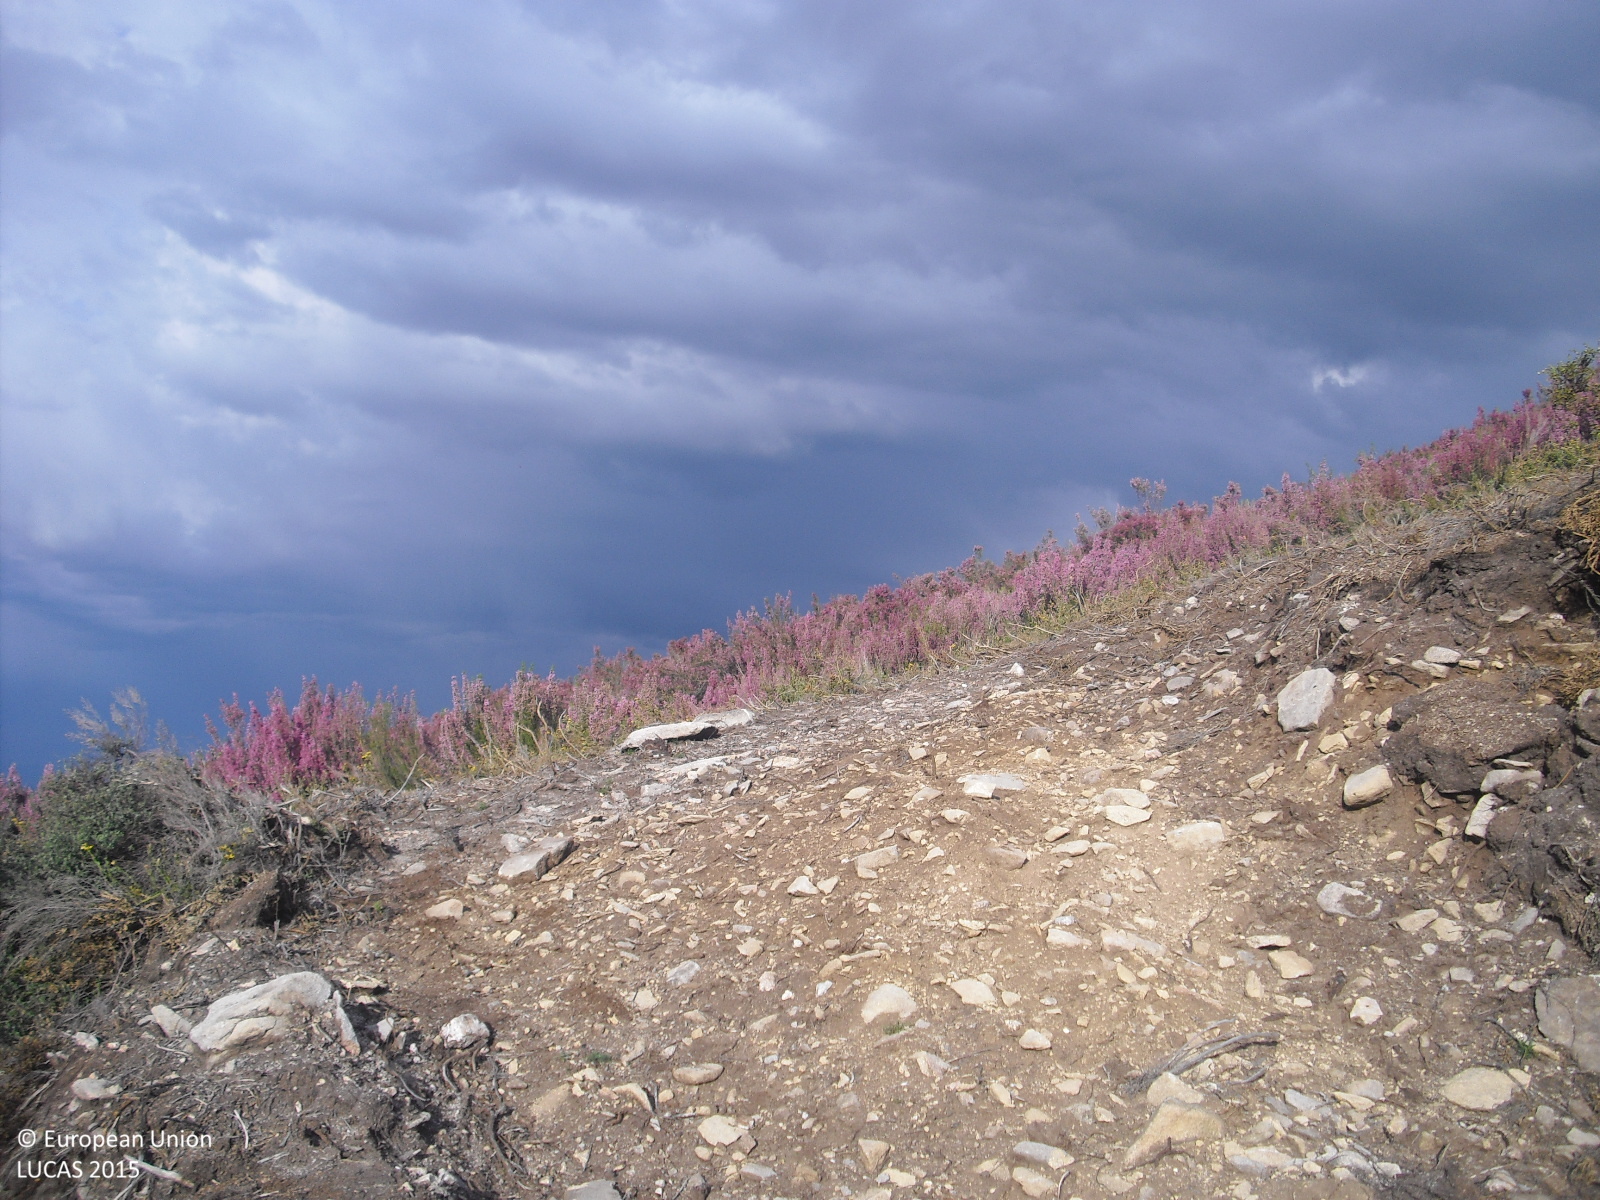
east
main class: Shrubland
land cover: Shrubland without tree cover
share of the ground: > 75 %
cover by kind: shrubs 90 %, herbaceous plants 5 %, unconsolidated bare surface 5 %
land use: Semi-natural and natural areas not in use
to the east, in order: Shrubland without tree cover; Other bare soil; Shrubland without tree cover; Broadleaved woodland; Rivers and streams; Broadleaved woodland
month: April
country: ES
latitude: 41.9272
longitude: -7.7095
